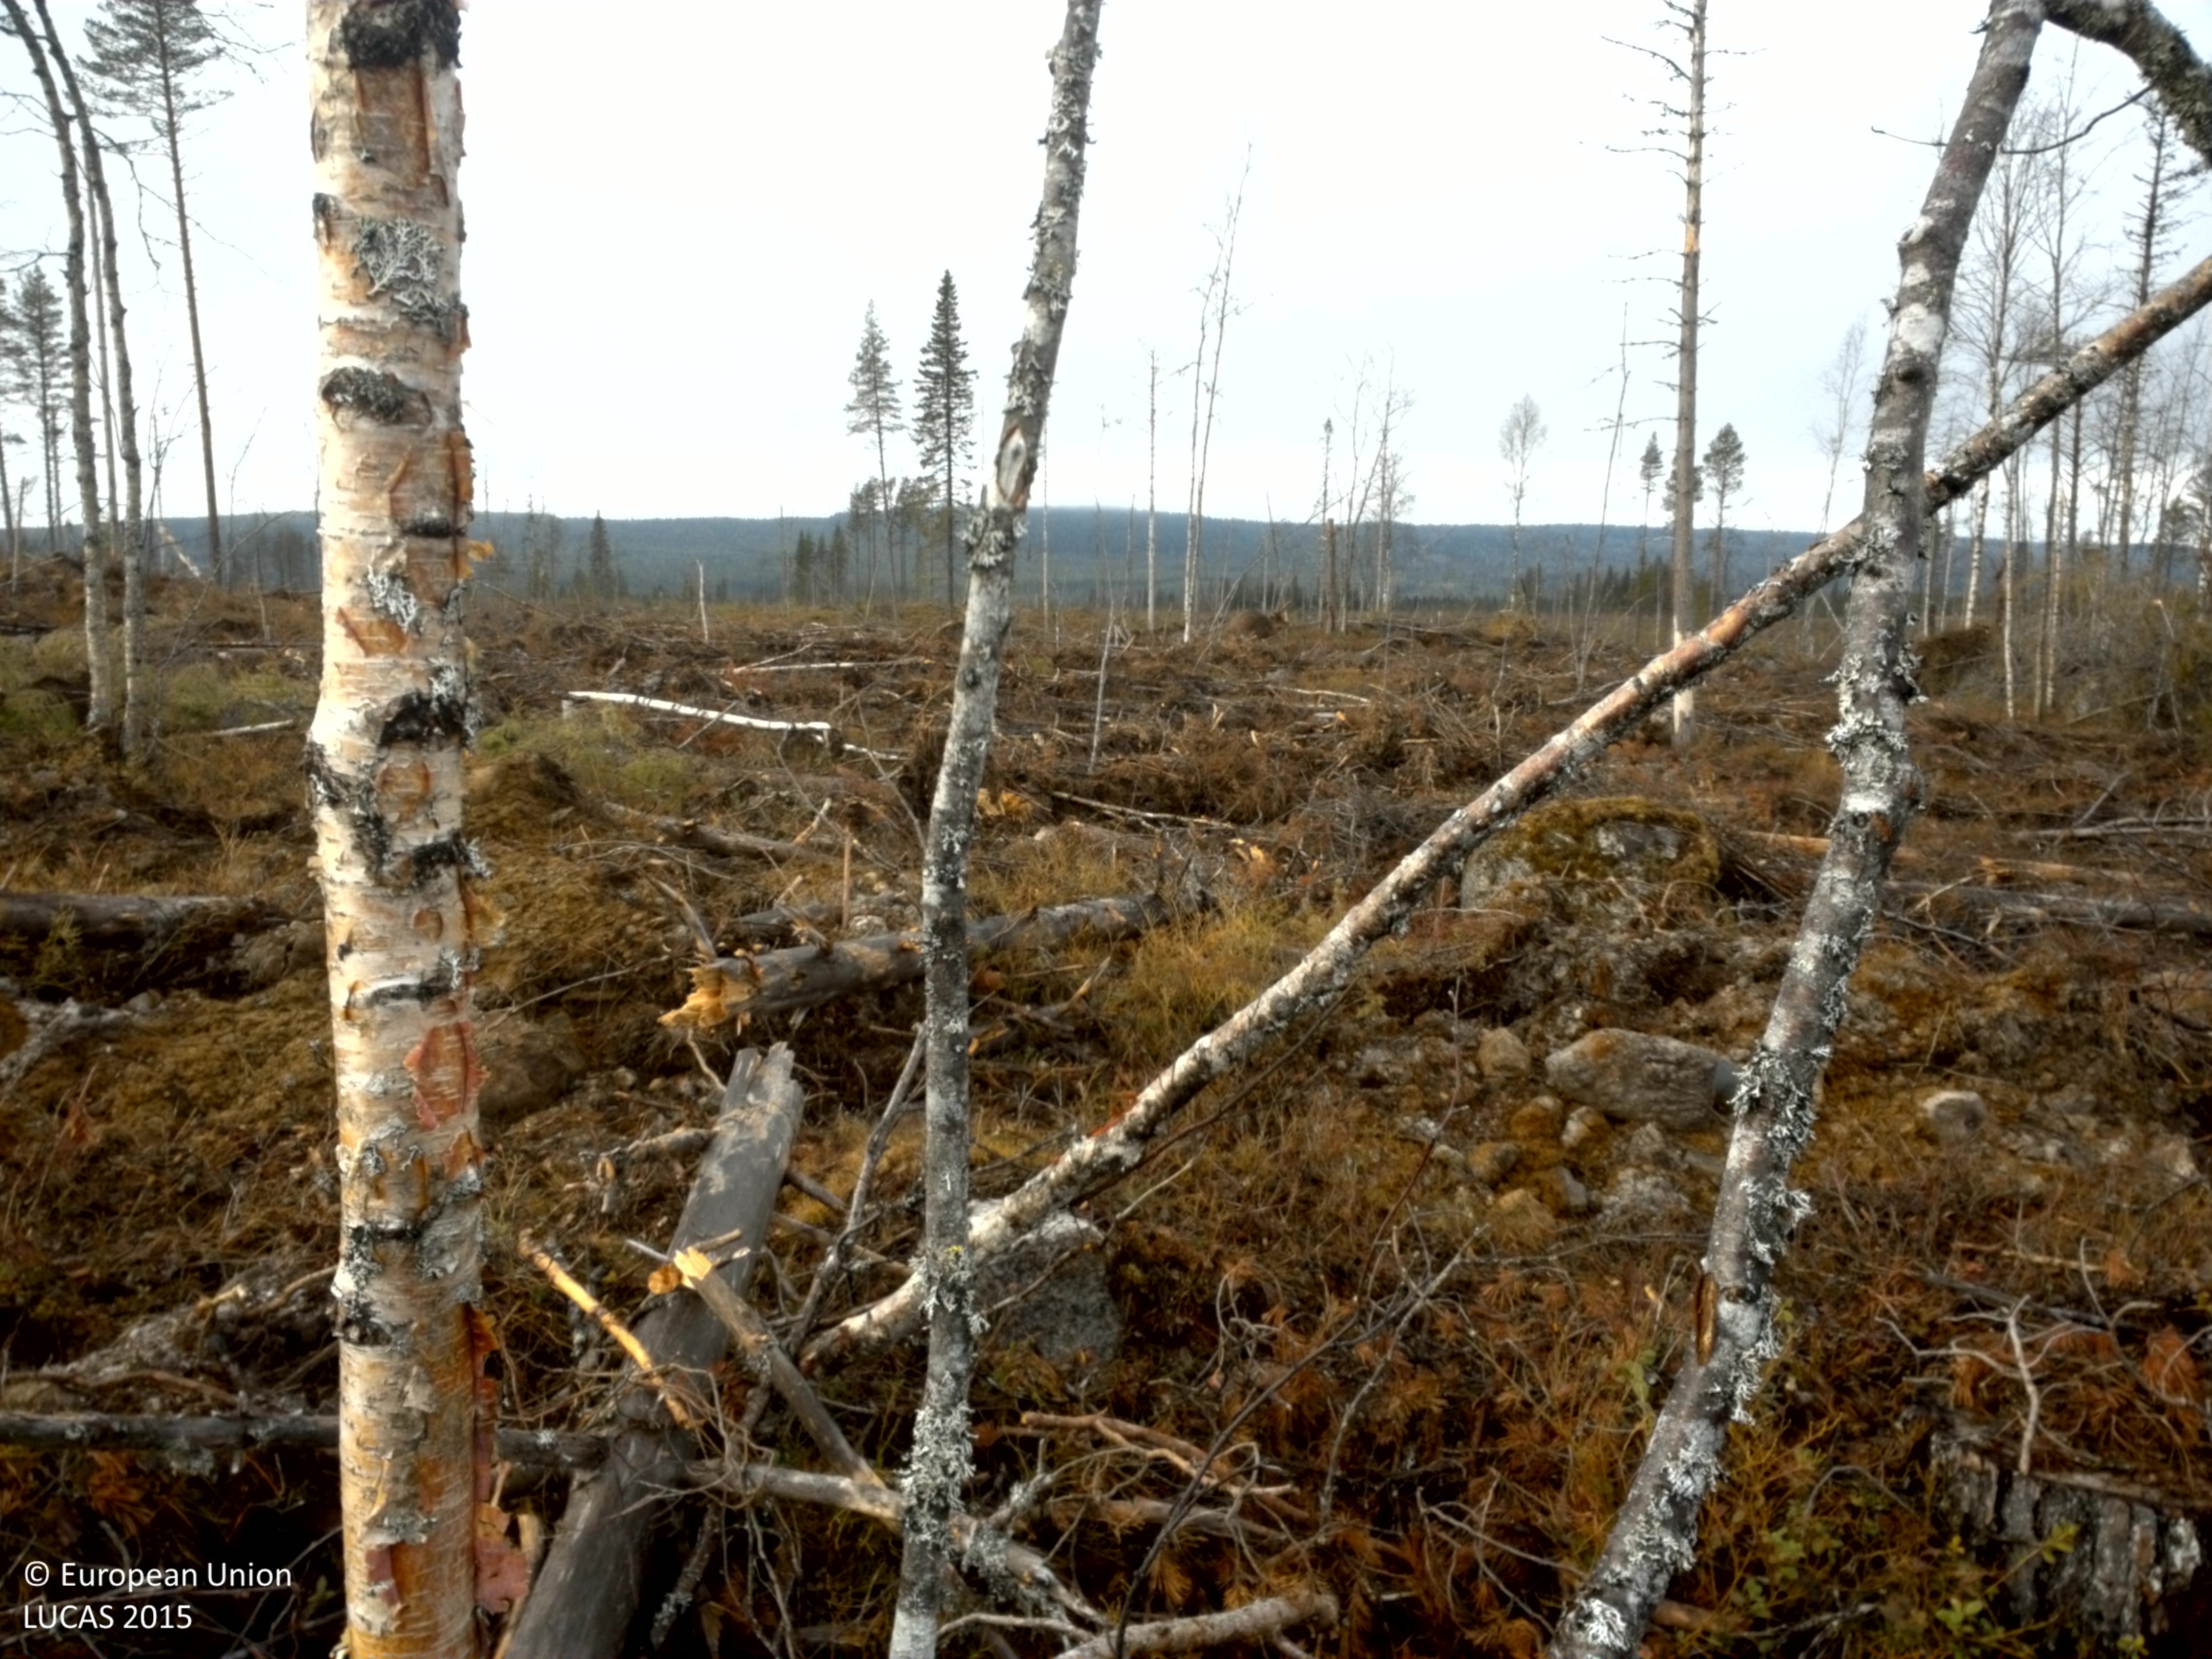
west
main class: Shrubland
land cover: Shrubland with sparse tree cover
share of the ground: 25 - 50 %
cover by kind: shrubs 35 %, unconsolidated bare surface 15 %, herbaceous plants 10 %, lichens and mosses 10 %, broadleaved forest trees 5 %, consolidated bare surface 5 %
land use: Forestry
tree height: < 5 m
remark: Clear cut
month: October
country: SE
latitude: 64.3995
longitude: 16.7509
